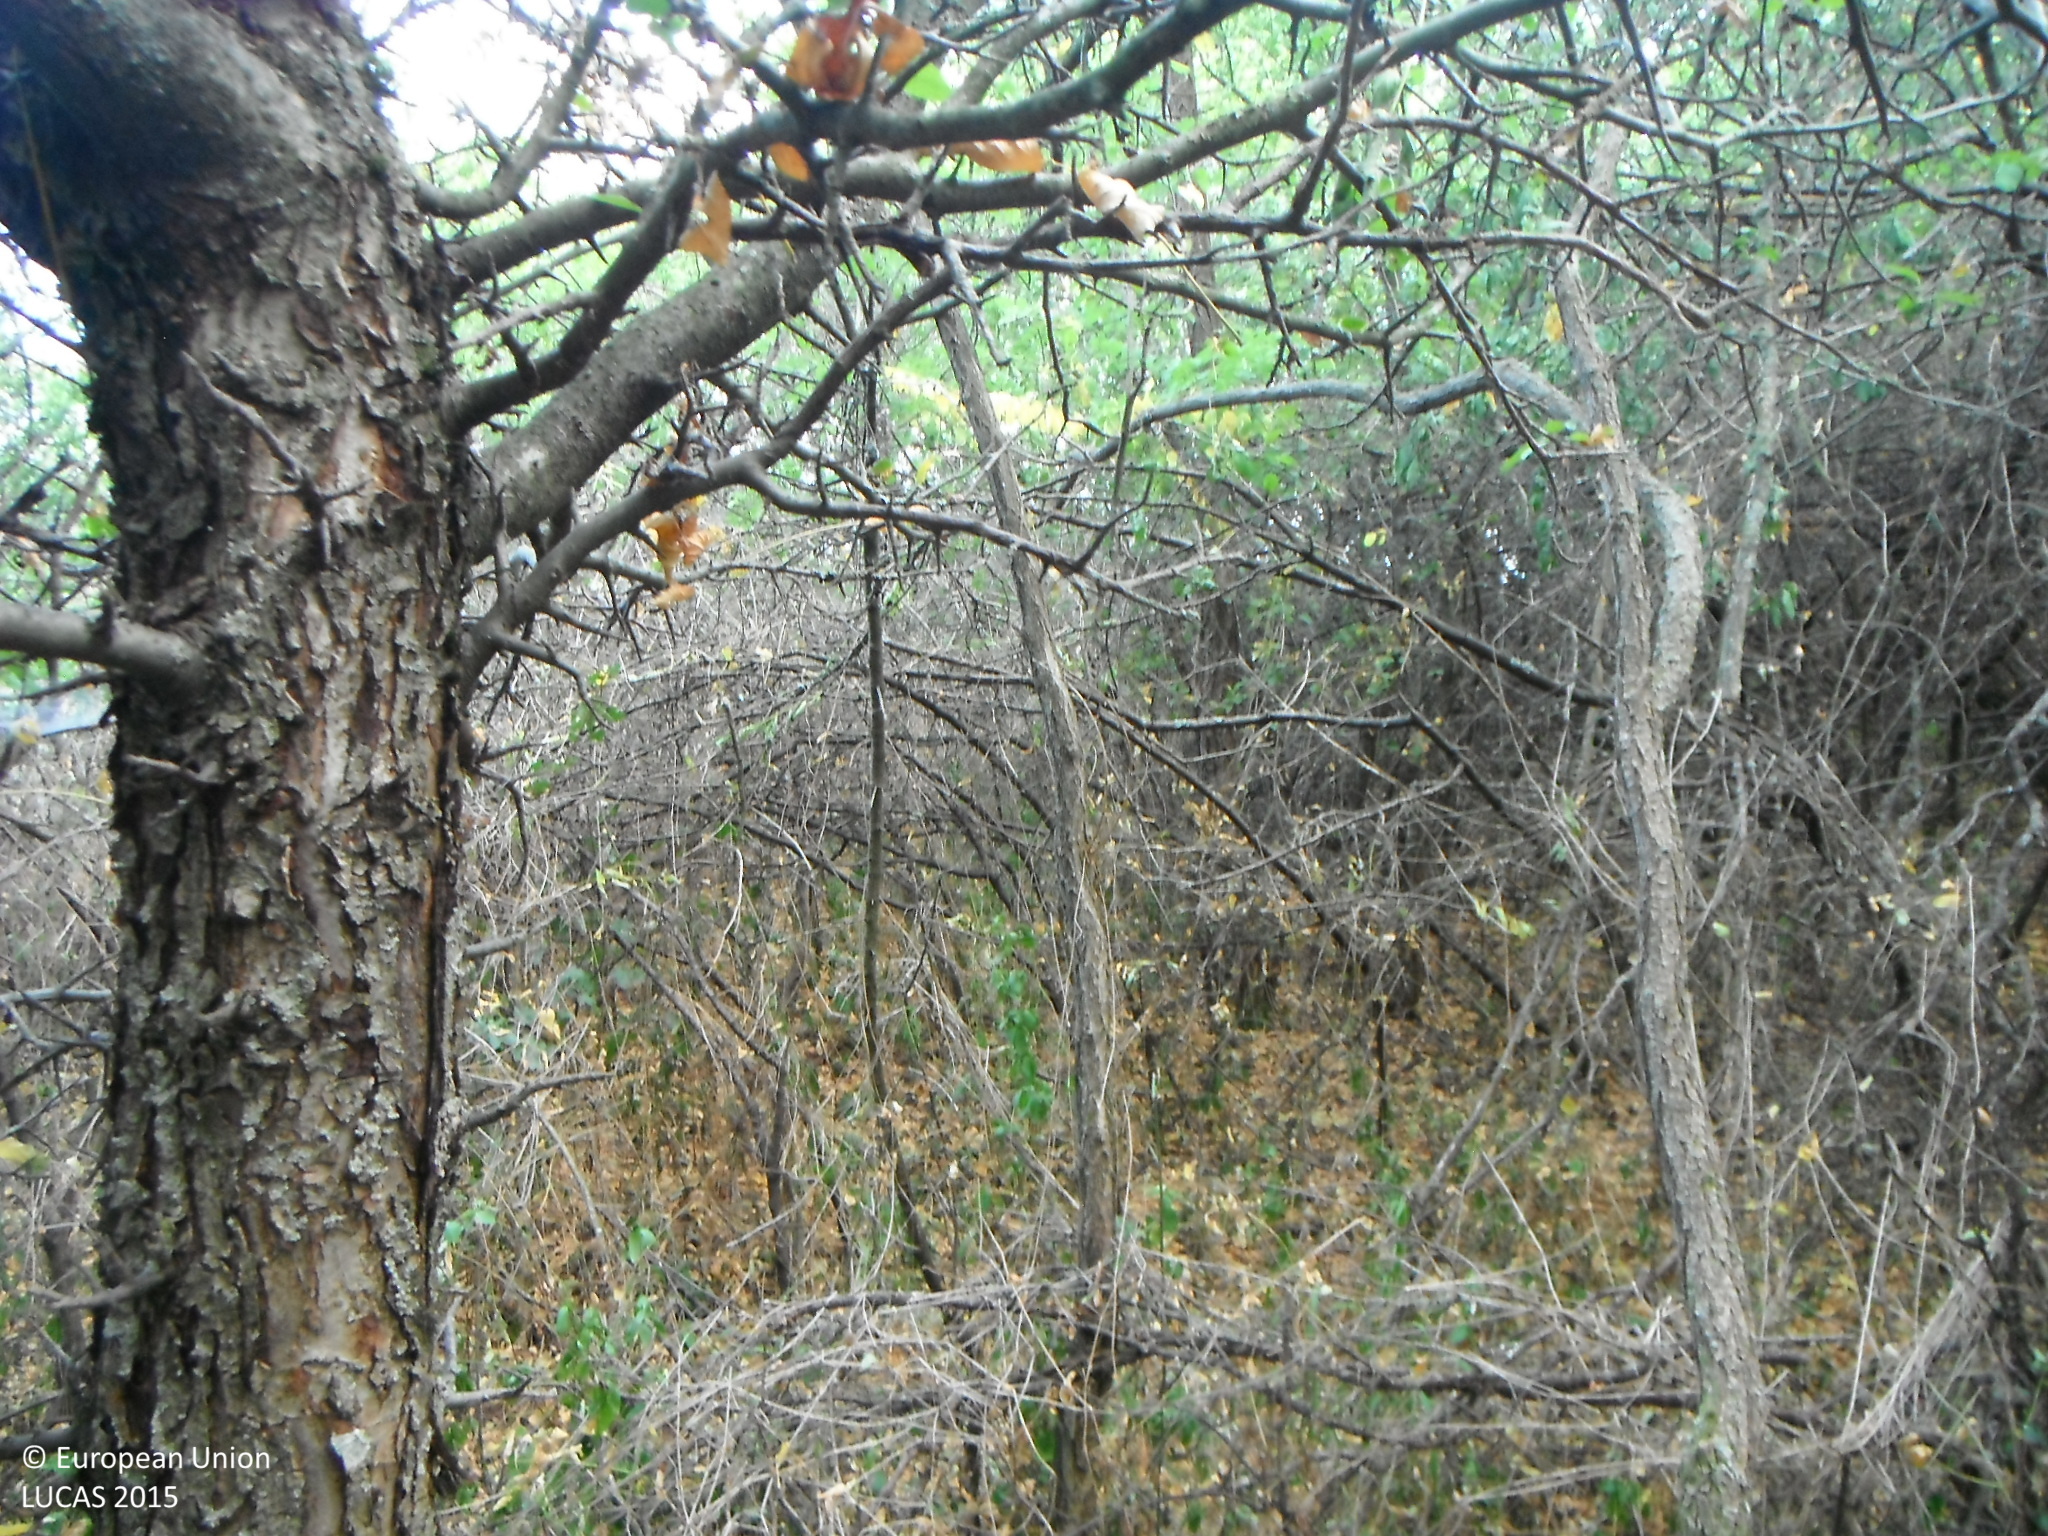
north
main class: Woodland
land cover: Broadleaved woodland
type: mesophytic deciduous forest
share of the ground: > 75 %
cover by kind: broadleaved forest trees 100 %
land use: Semi-natural and natural areas not in use
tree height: > 5 m
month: July
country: SK
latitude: 48.2640
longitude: 19.0869
